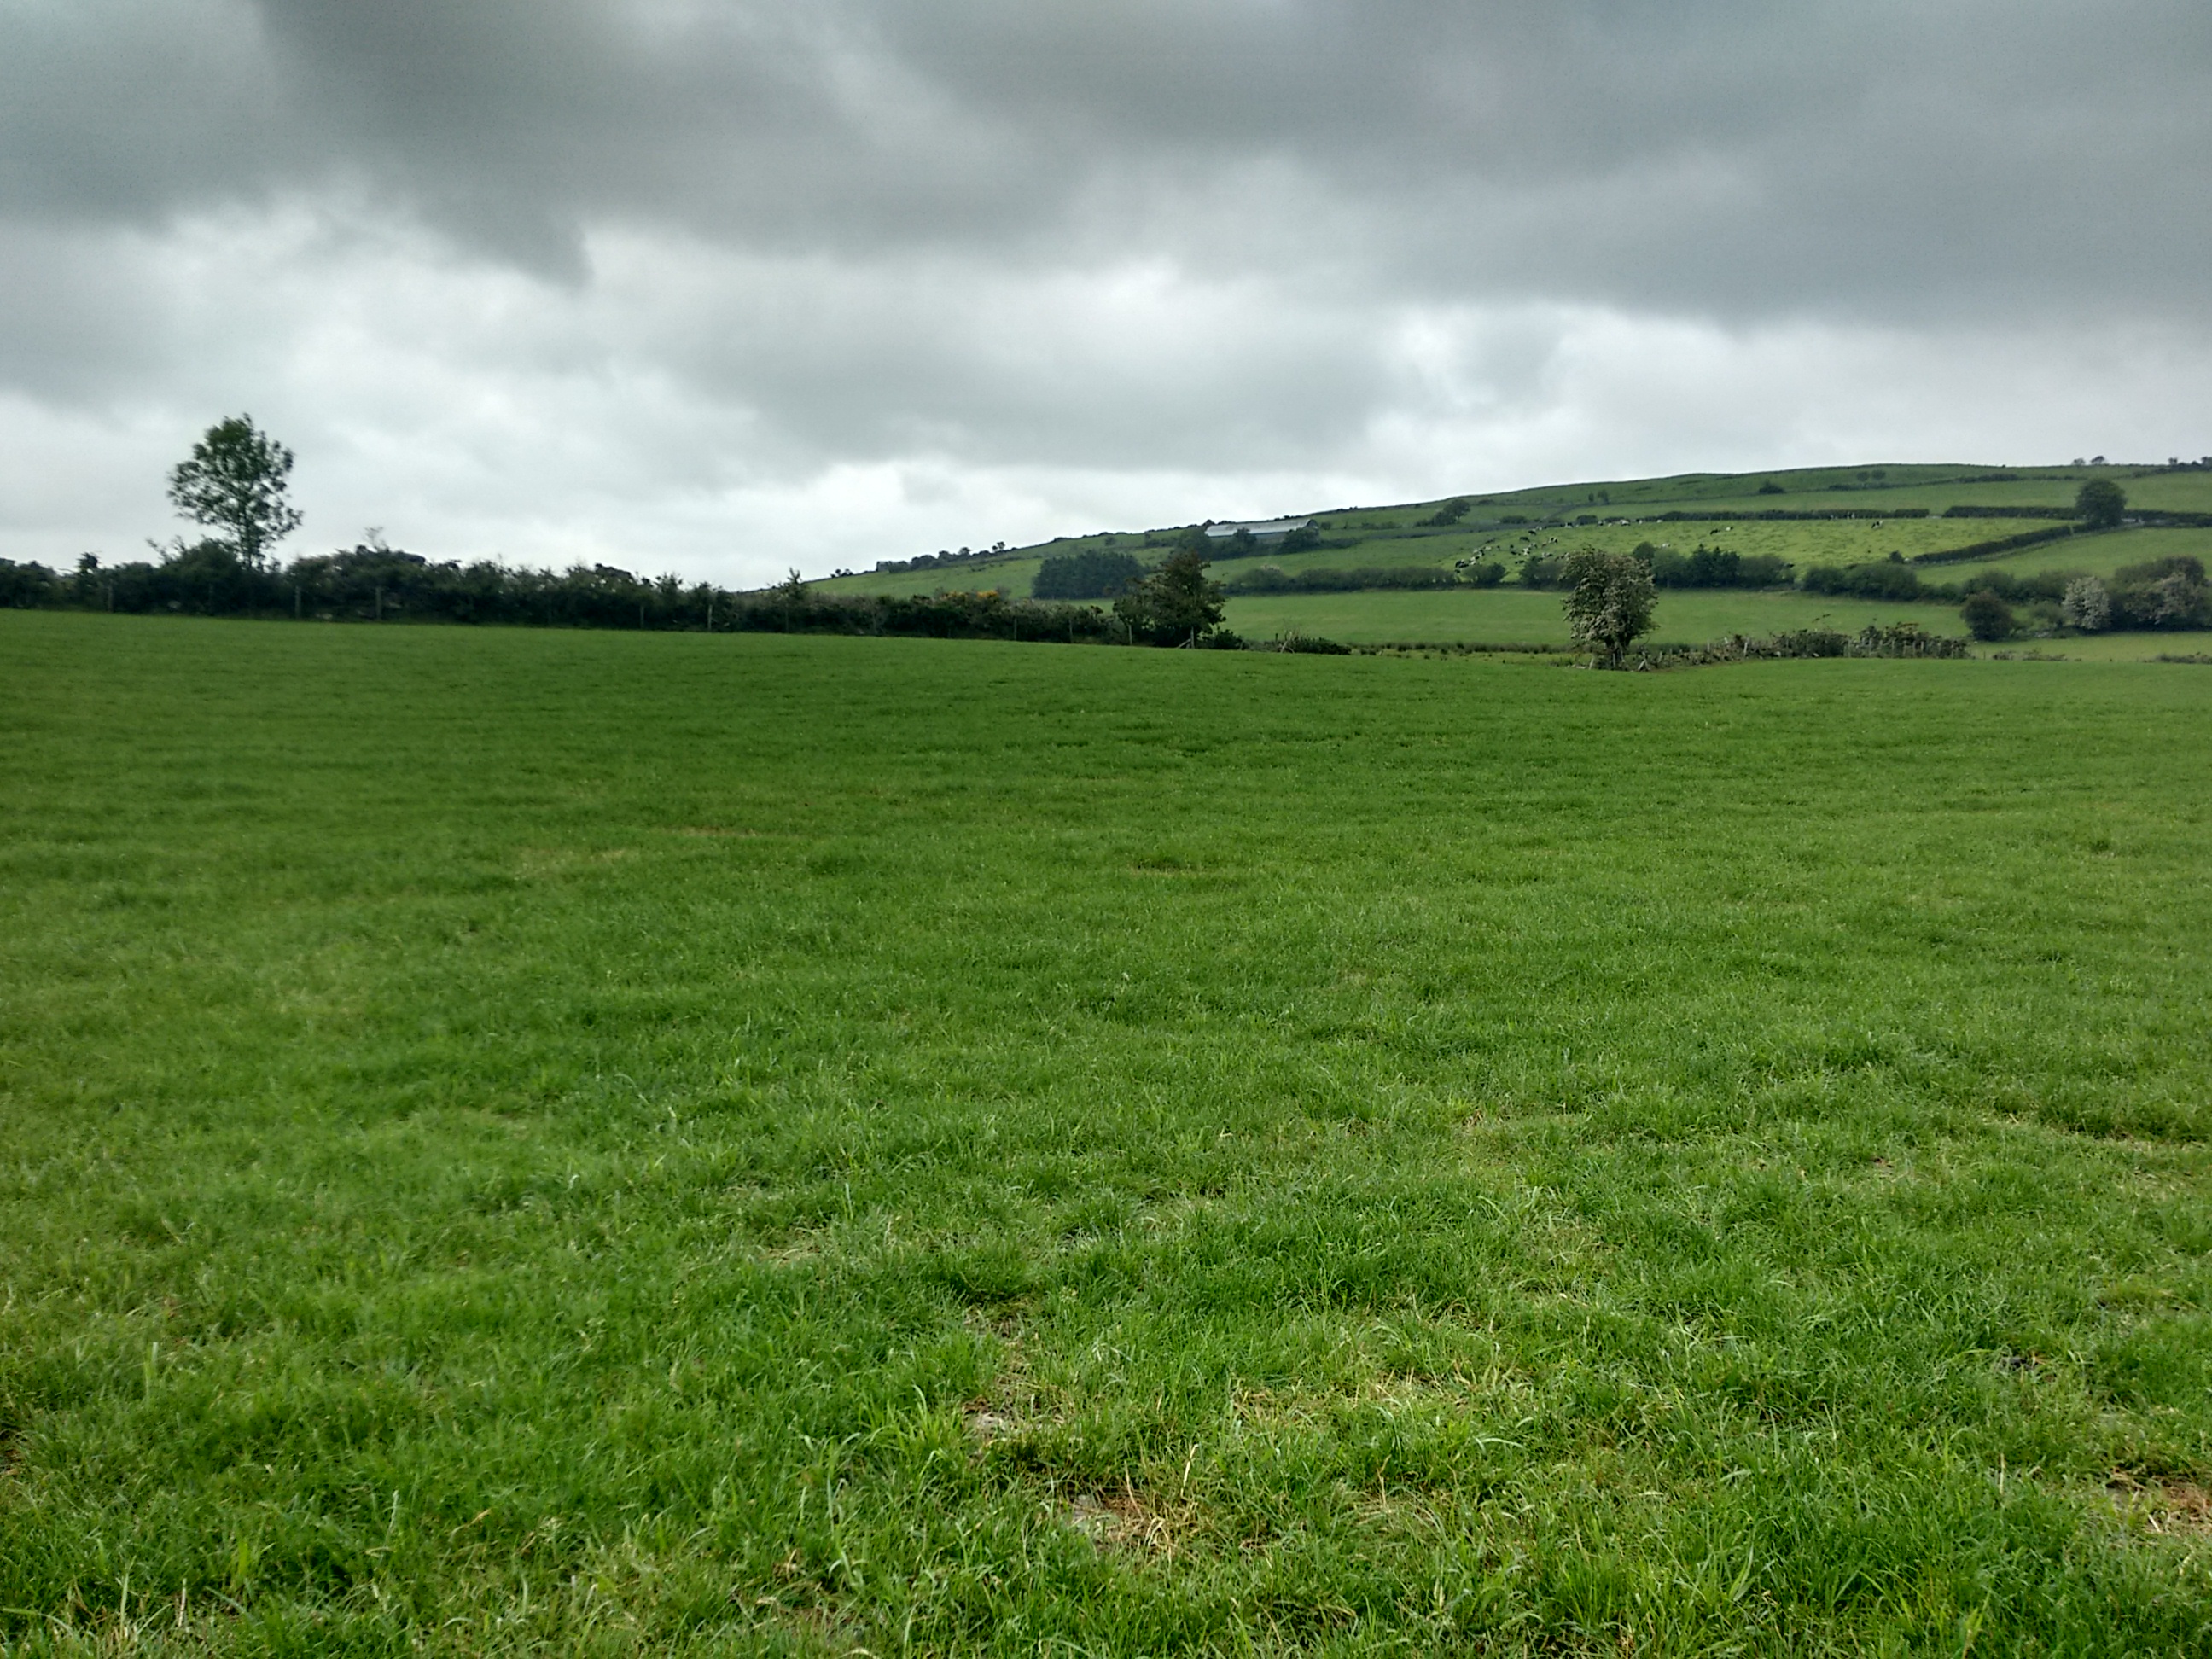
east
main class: Grassland
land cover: Grassland without tree/shrub cover
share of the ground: > 75 %
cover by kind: herbaceous plants 100 %
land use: Agriculture (excluding fallow land and kitchen gardens)
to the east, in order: Grassland without tree/shrub cover; Rock outcrops; Fences; Grass margins; Fences; Grassland without tree/shrub cover; Fences; Abandoned hedges; Fences; Abandoned hedges; Grassland without tree/shrub cover; Fences; Grassland without tree/shrub cover
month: June
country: GB
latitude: 54.6783
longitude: -7.6065
